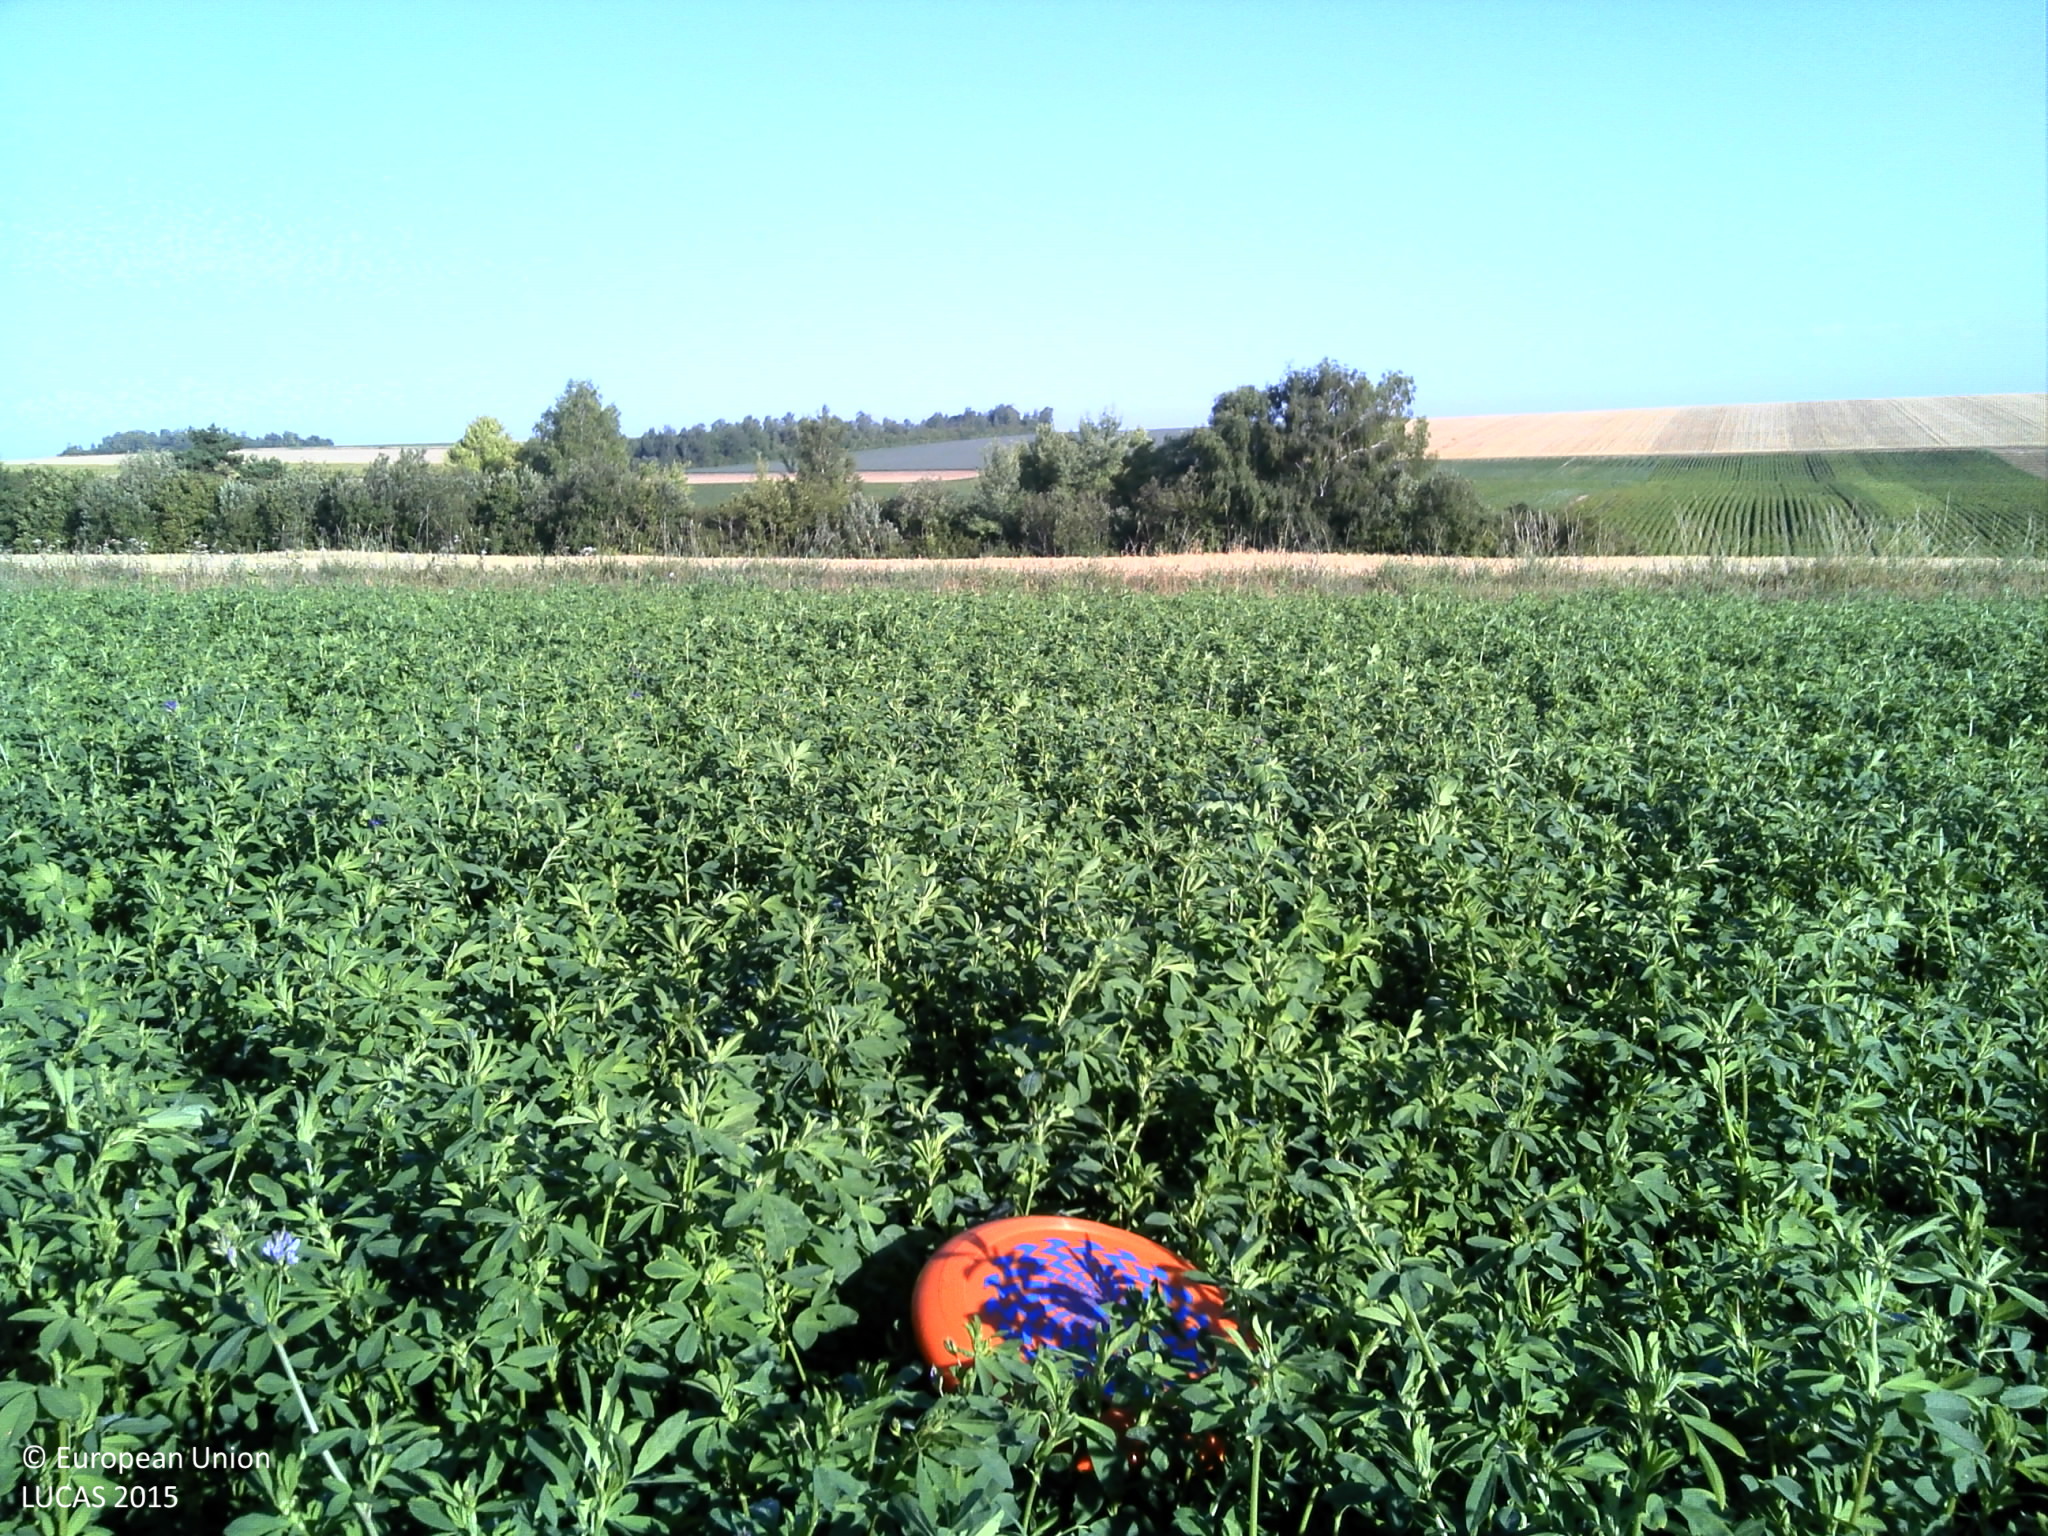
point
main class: Cropland
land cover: Lucerne
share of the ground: > 75 %
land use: Agriculture (excluding fallow land and kitchen gardens)
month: August
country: FR
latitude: 49.0850
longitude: 4.6433
